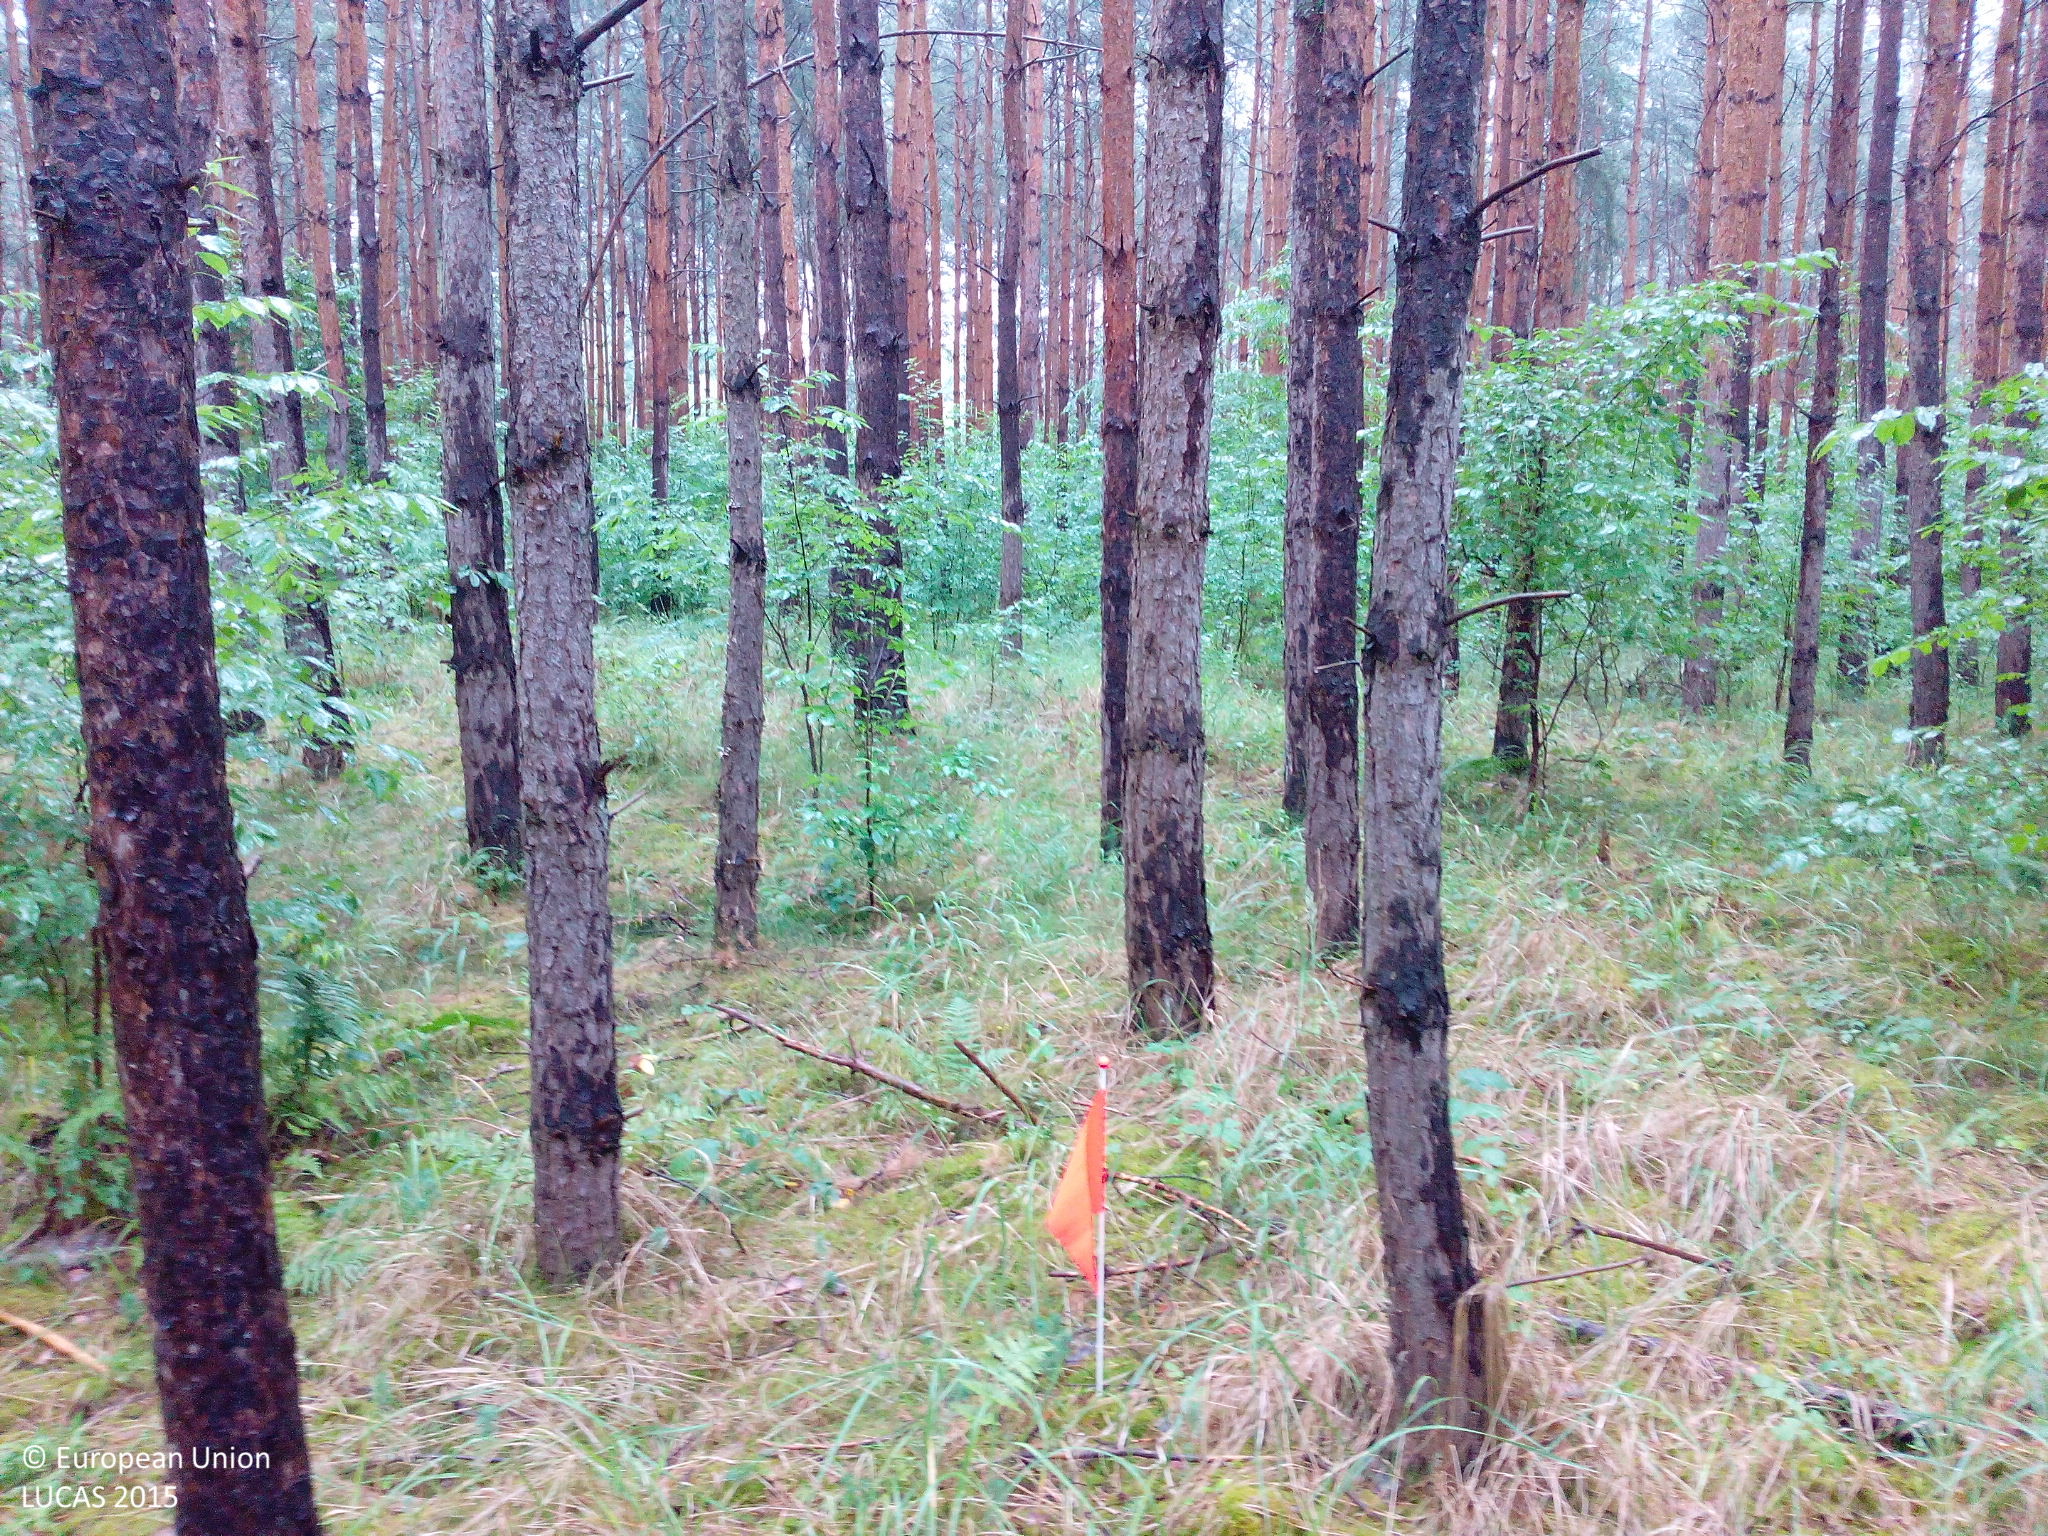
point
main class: Woodland
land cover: Pine dominated coniferous woodland
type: hemiboreal forest and nemoral coniferous forest and mixed broadleaved-coniferous forest
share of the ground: > 75 %
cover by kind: coniferous forest trees 70 %, broadleaved forest trees 15 %, shrubs 5 %, herbaceous plants 5 %, unconsolidated bare surface 5 %
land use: Forestry
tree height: > 5 m
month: June
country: DE
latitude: 49.5455
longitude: 8.5493
